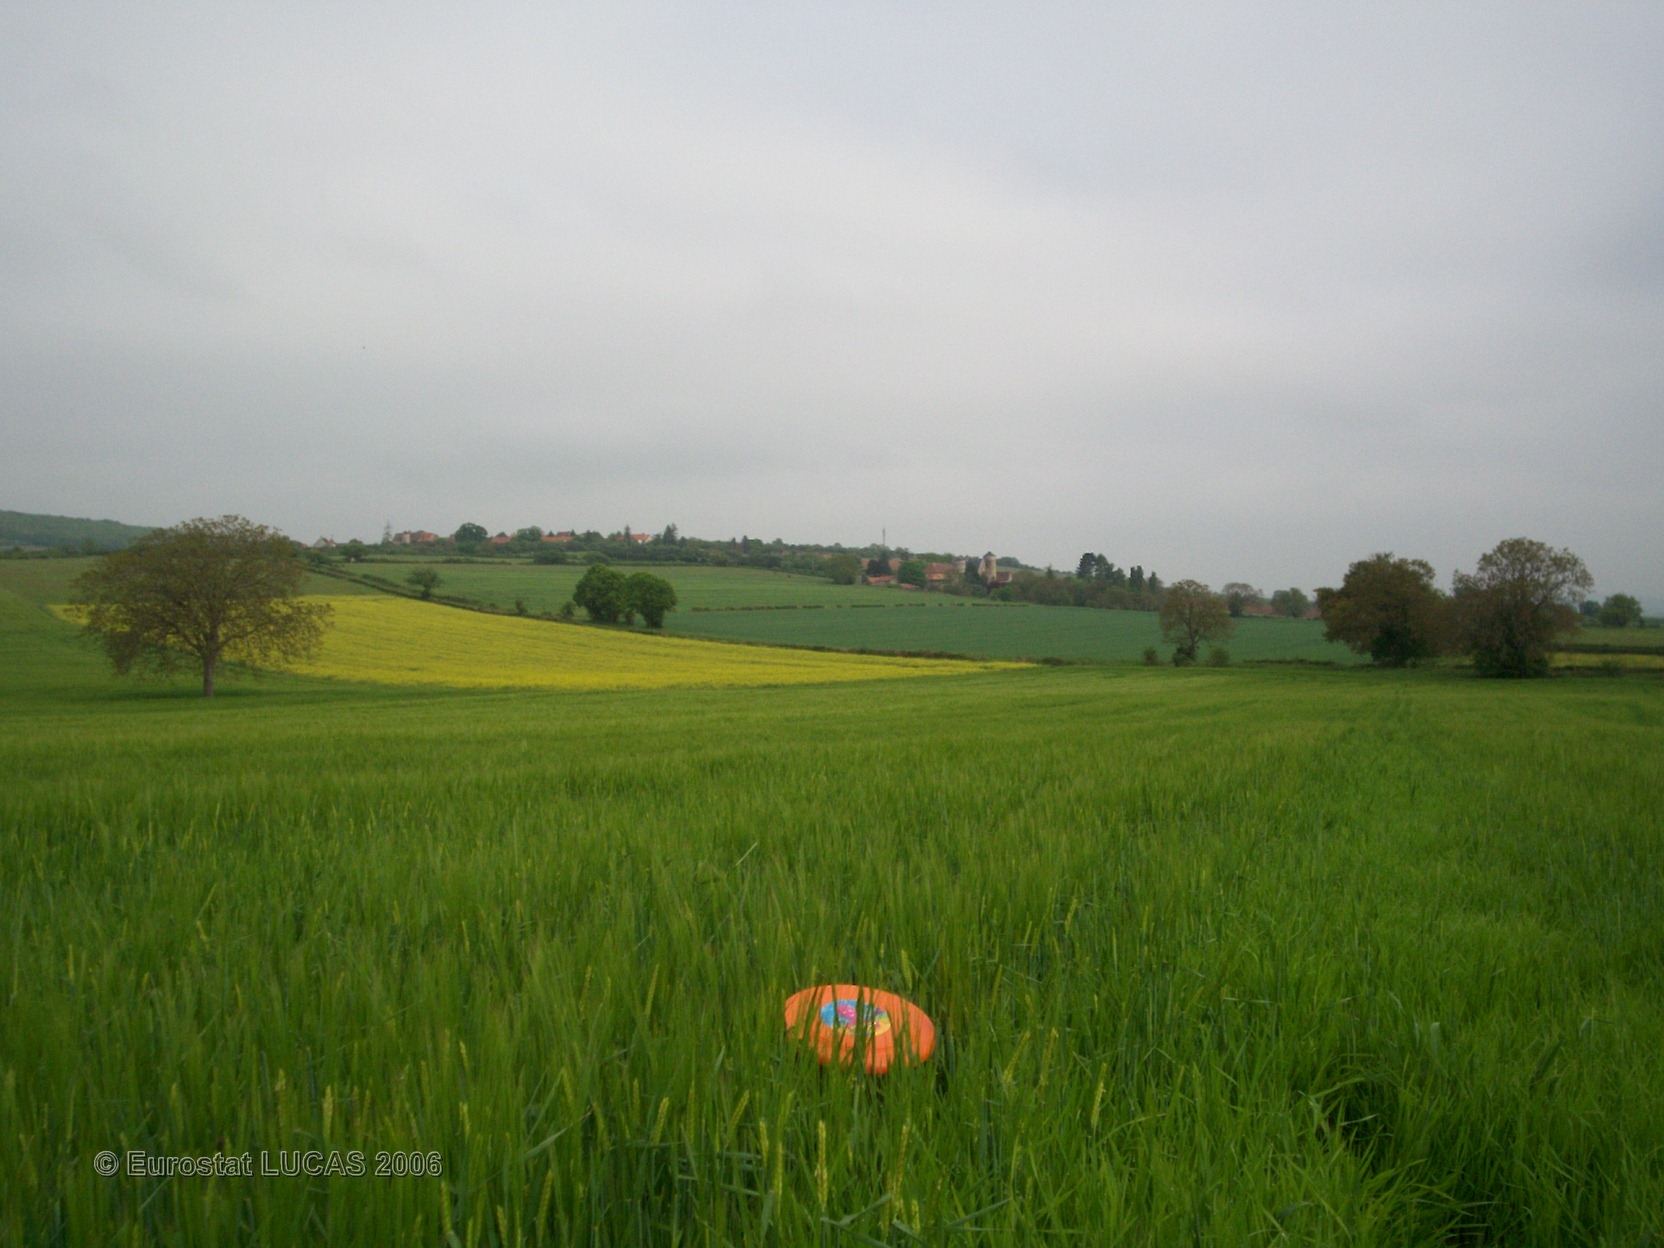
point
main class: Cropland
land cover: Barley
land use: Agriculture (excluding fallow land and kitchen gardens)
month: May
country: FR
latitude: 46.5059
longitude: 4.6455
